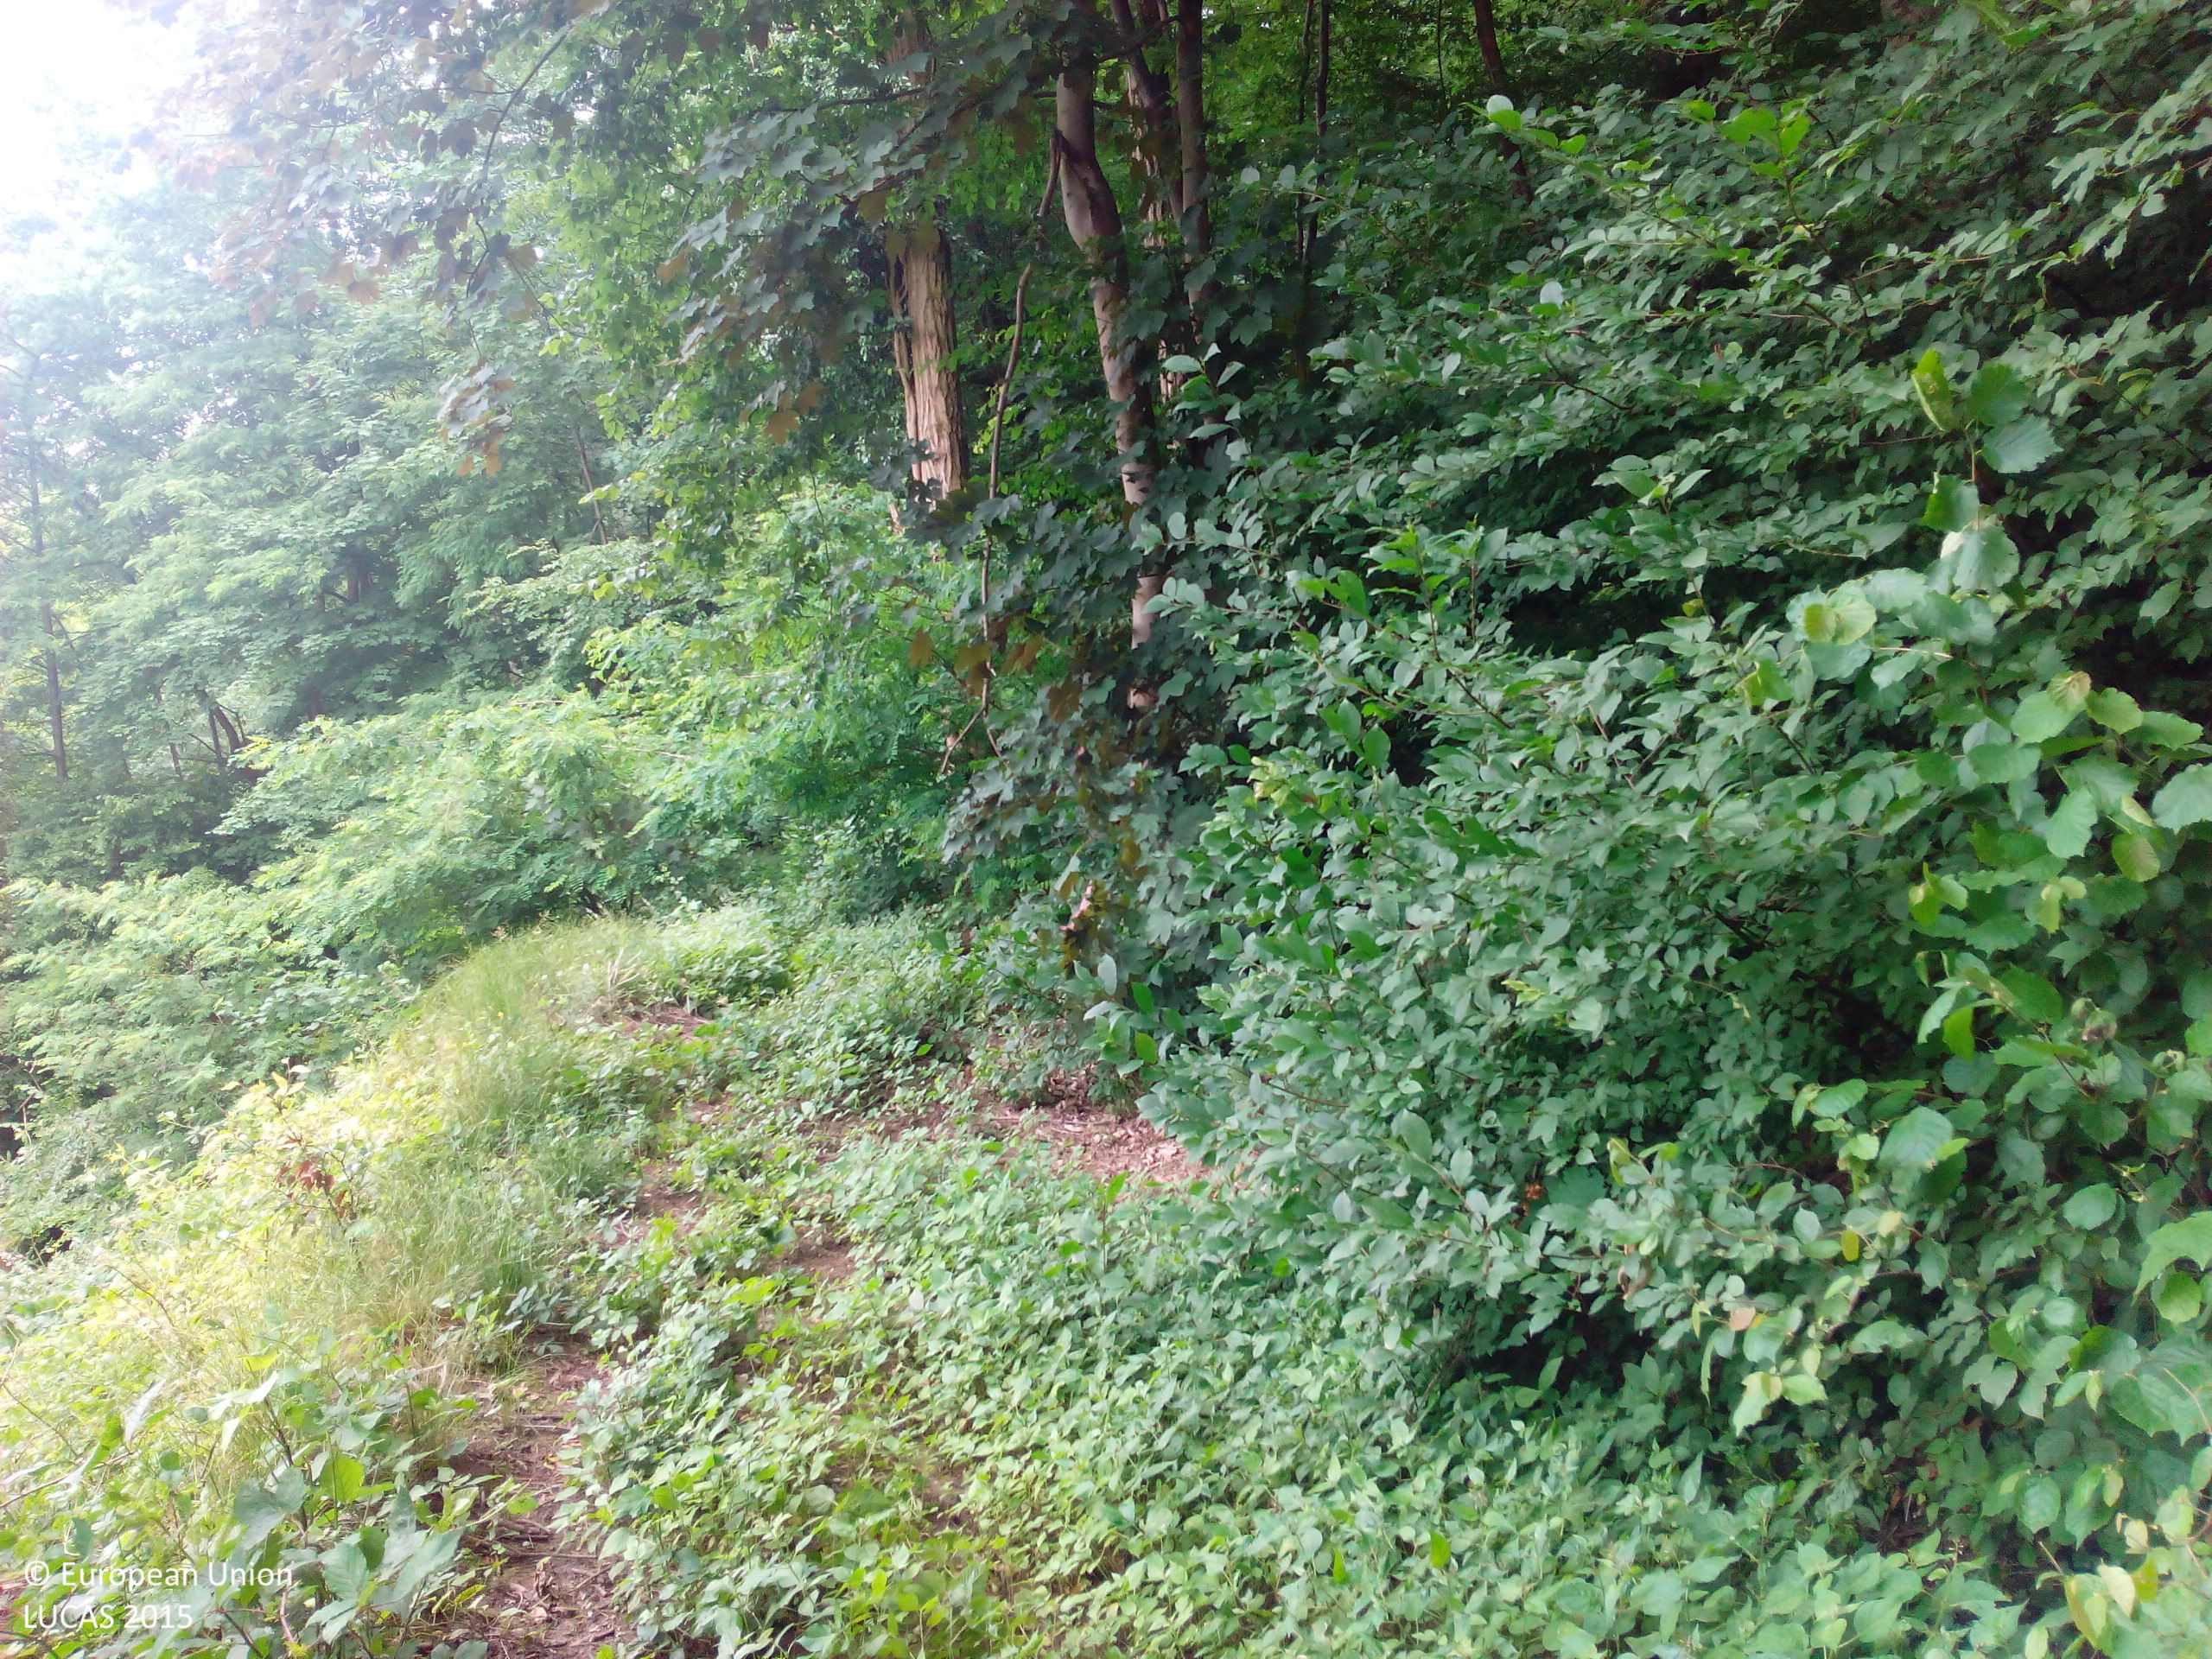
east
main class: Woodland
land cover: Broadleaved woodland
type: mesophytic deciduous forest
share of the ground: > 75 %
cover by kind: broadleaved forest trees 80 %, herbaceous plants 10 %, shrubs 5 %, consolidated bare surface 5 %
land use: Abandoned areas
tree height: > 5 m
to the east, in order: Broadleaved woodland; Grassland without tree/shrub cover; Lines of trees; Tracks; Grass margins; Broadleaved woodland
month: June
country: DE
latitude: 48.6209
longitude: 8.0880
